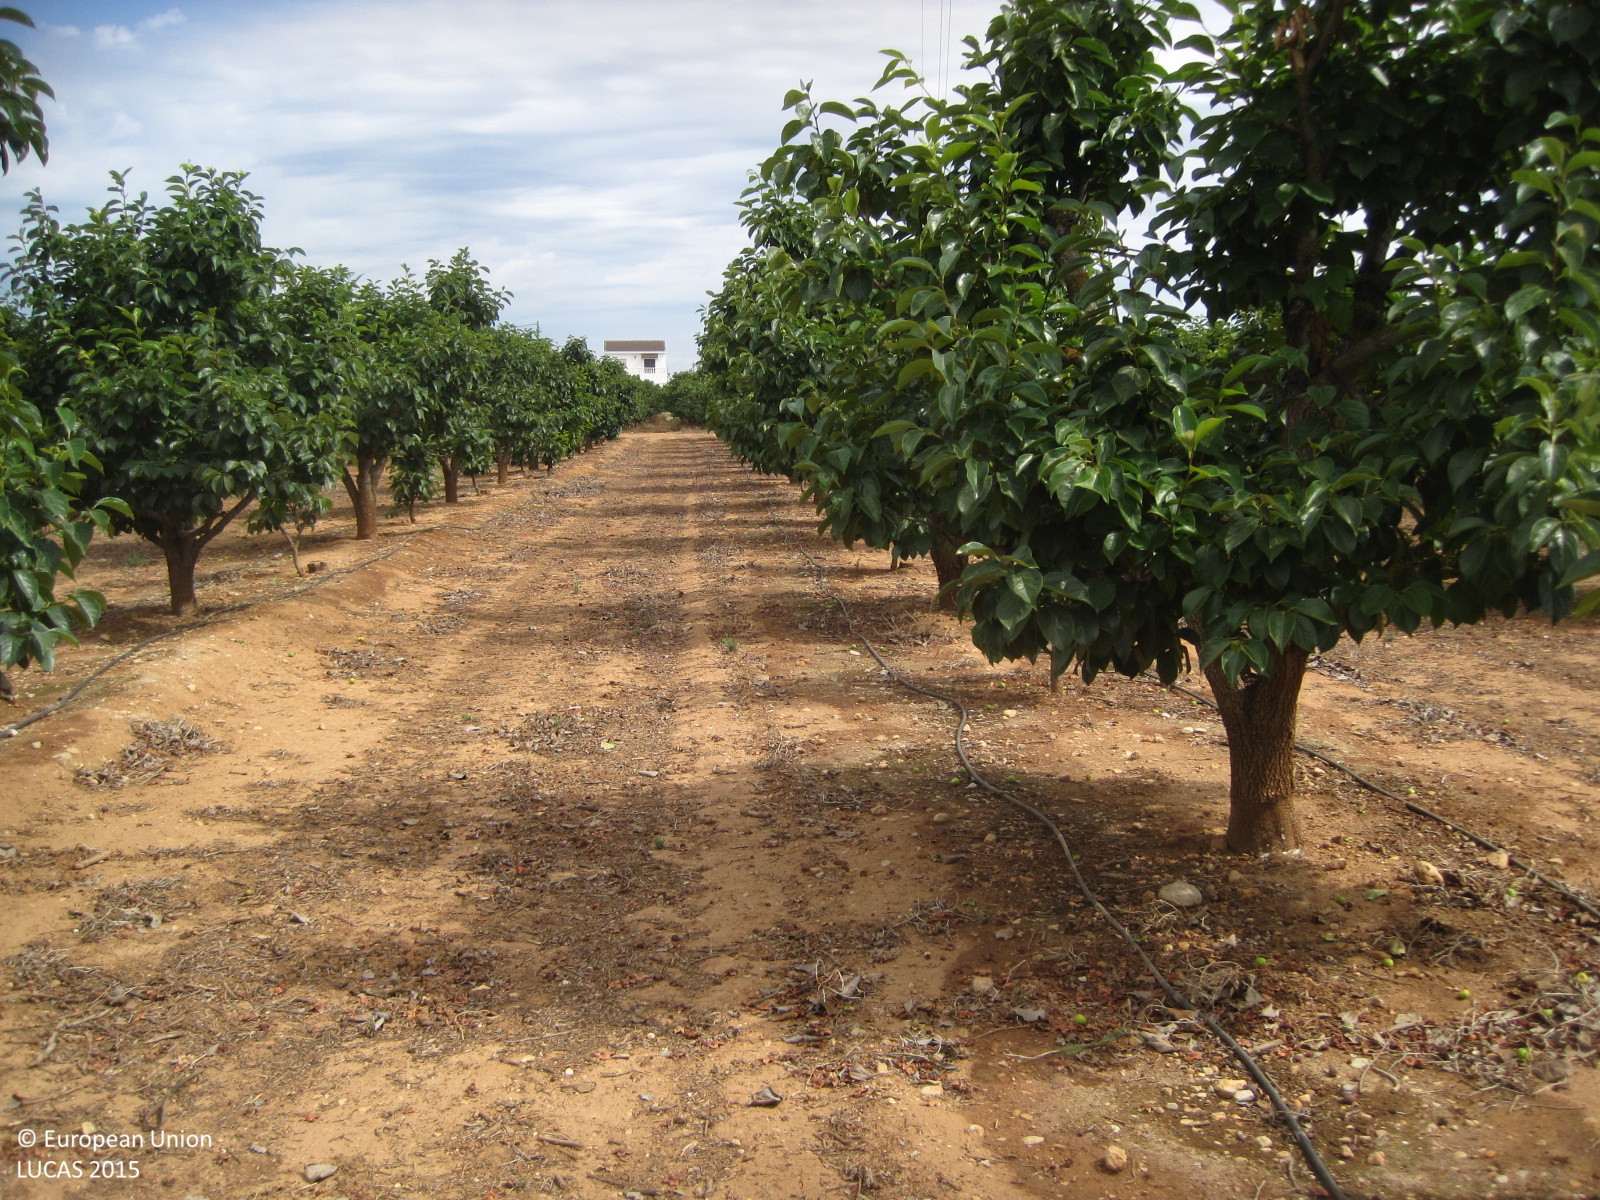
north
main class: Cropland
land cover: Other fruit trees and berries
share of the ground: 25 - 50 %
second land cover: Other bare soil
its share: > 75 %
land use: Agriculture (excluding fallow land and kitchen gardens)
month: June
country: ES
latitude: 39.1870
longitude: -0.5418
